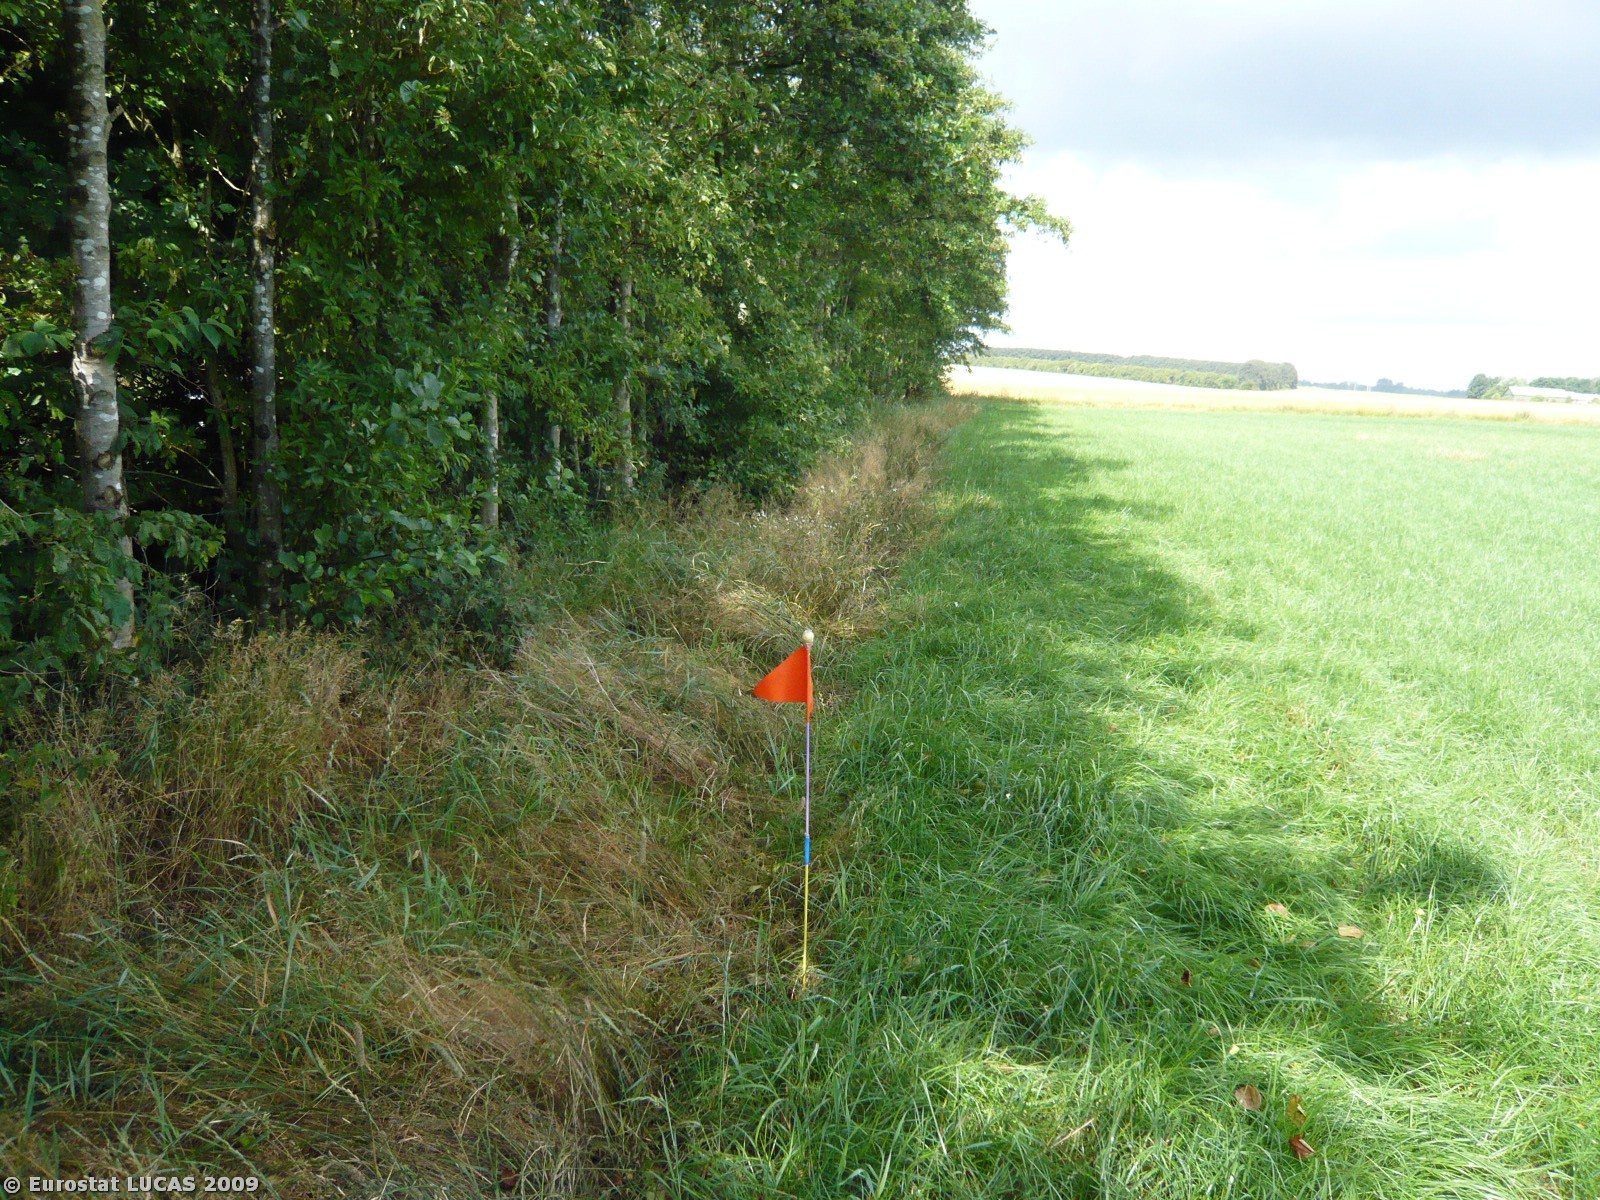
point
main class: Grassland
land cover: Grassland without tree/shrub cover
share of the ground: > 75 %
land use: Agriculture (excluding fallow land and kitchen gardens)
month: July
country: DK
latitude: 55.5956
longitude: 12.0771
